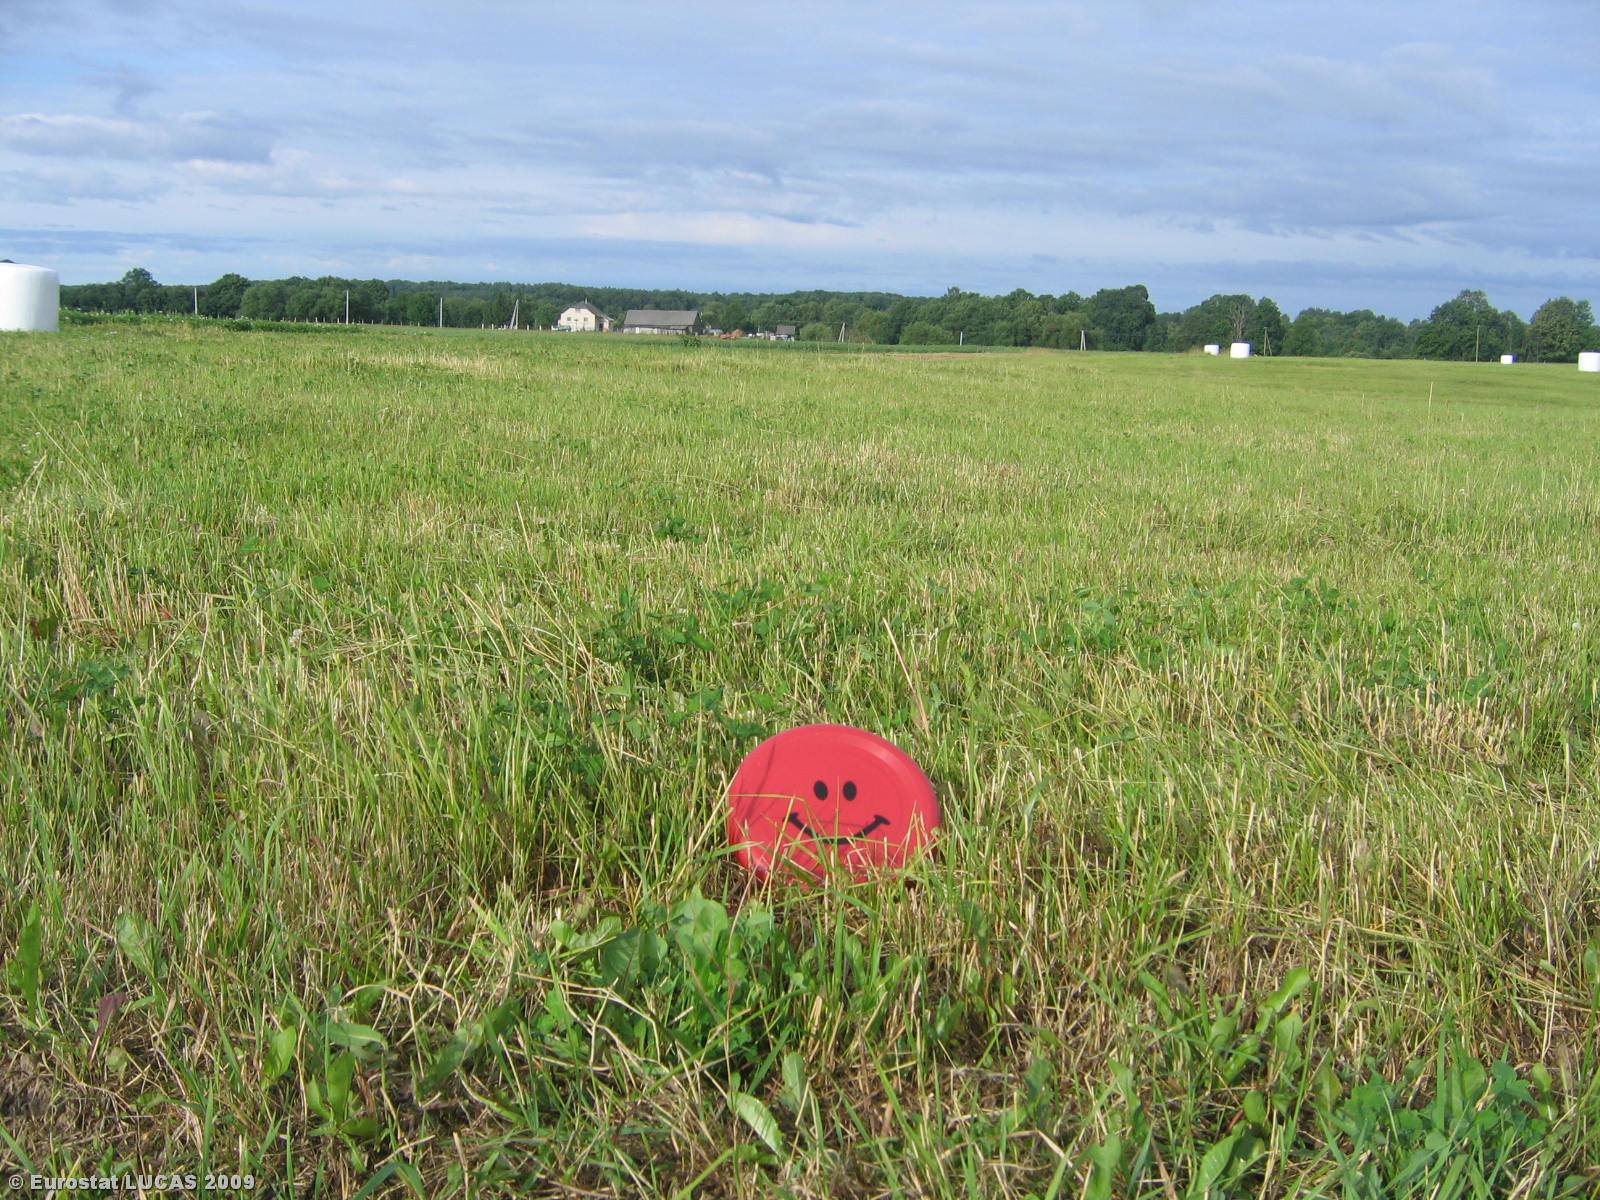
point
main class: Grassland
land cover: Grassland without tree/shrub cover
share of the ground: > 75 %
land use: Agriculture (excluding fallow land and kitchen gardens)
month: July
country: LT
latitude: 55.3324
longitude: 22.7236
